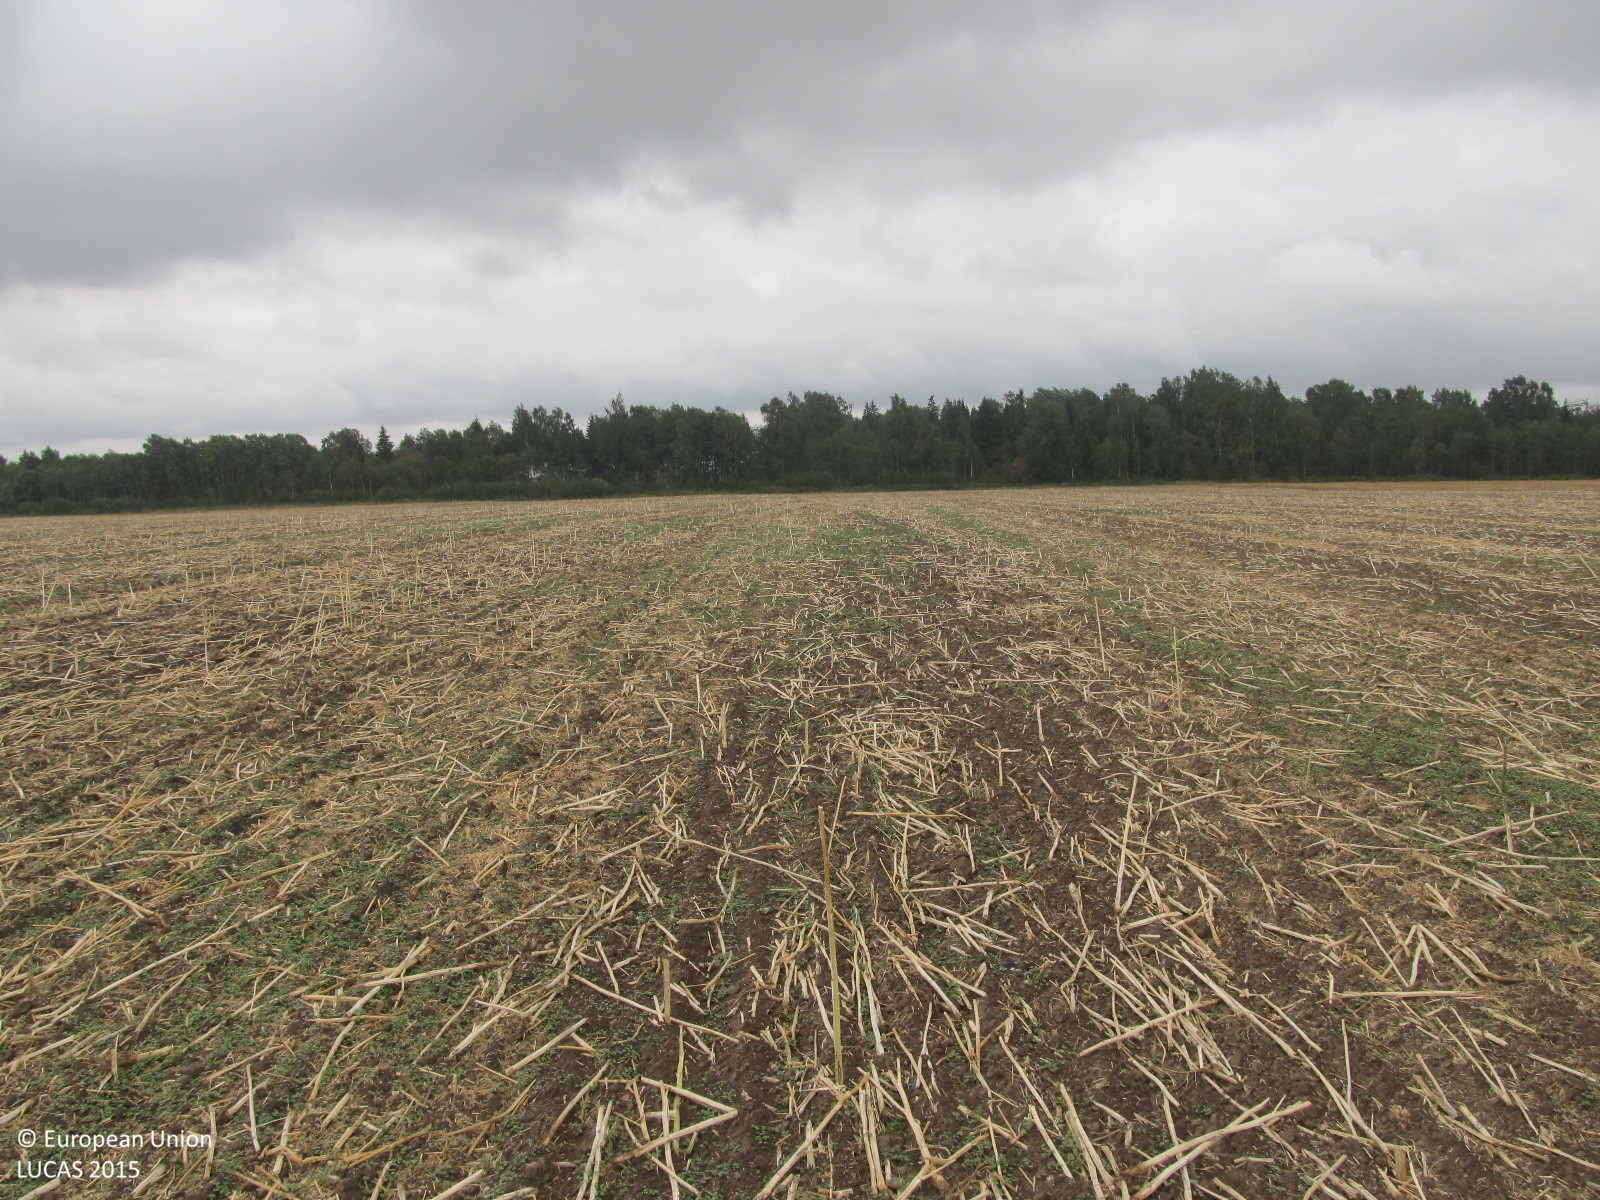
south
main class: Cropland
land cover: Rape and turnip rape
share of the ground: 25 - 50 %
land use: Agriculture (excluding fallow land and kitchen gardens)
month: August
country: LT
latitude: 55.9689
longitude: 23.0954
